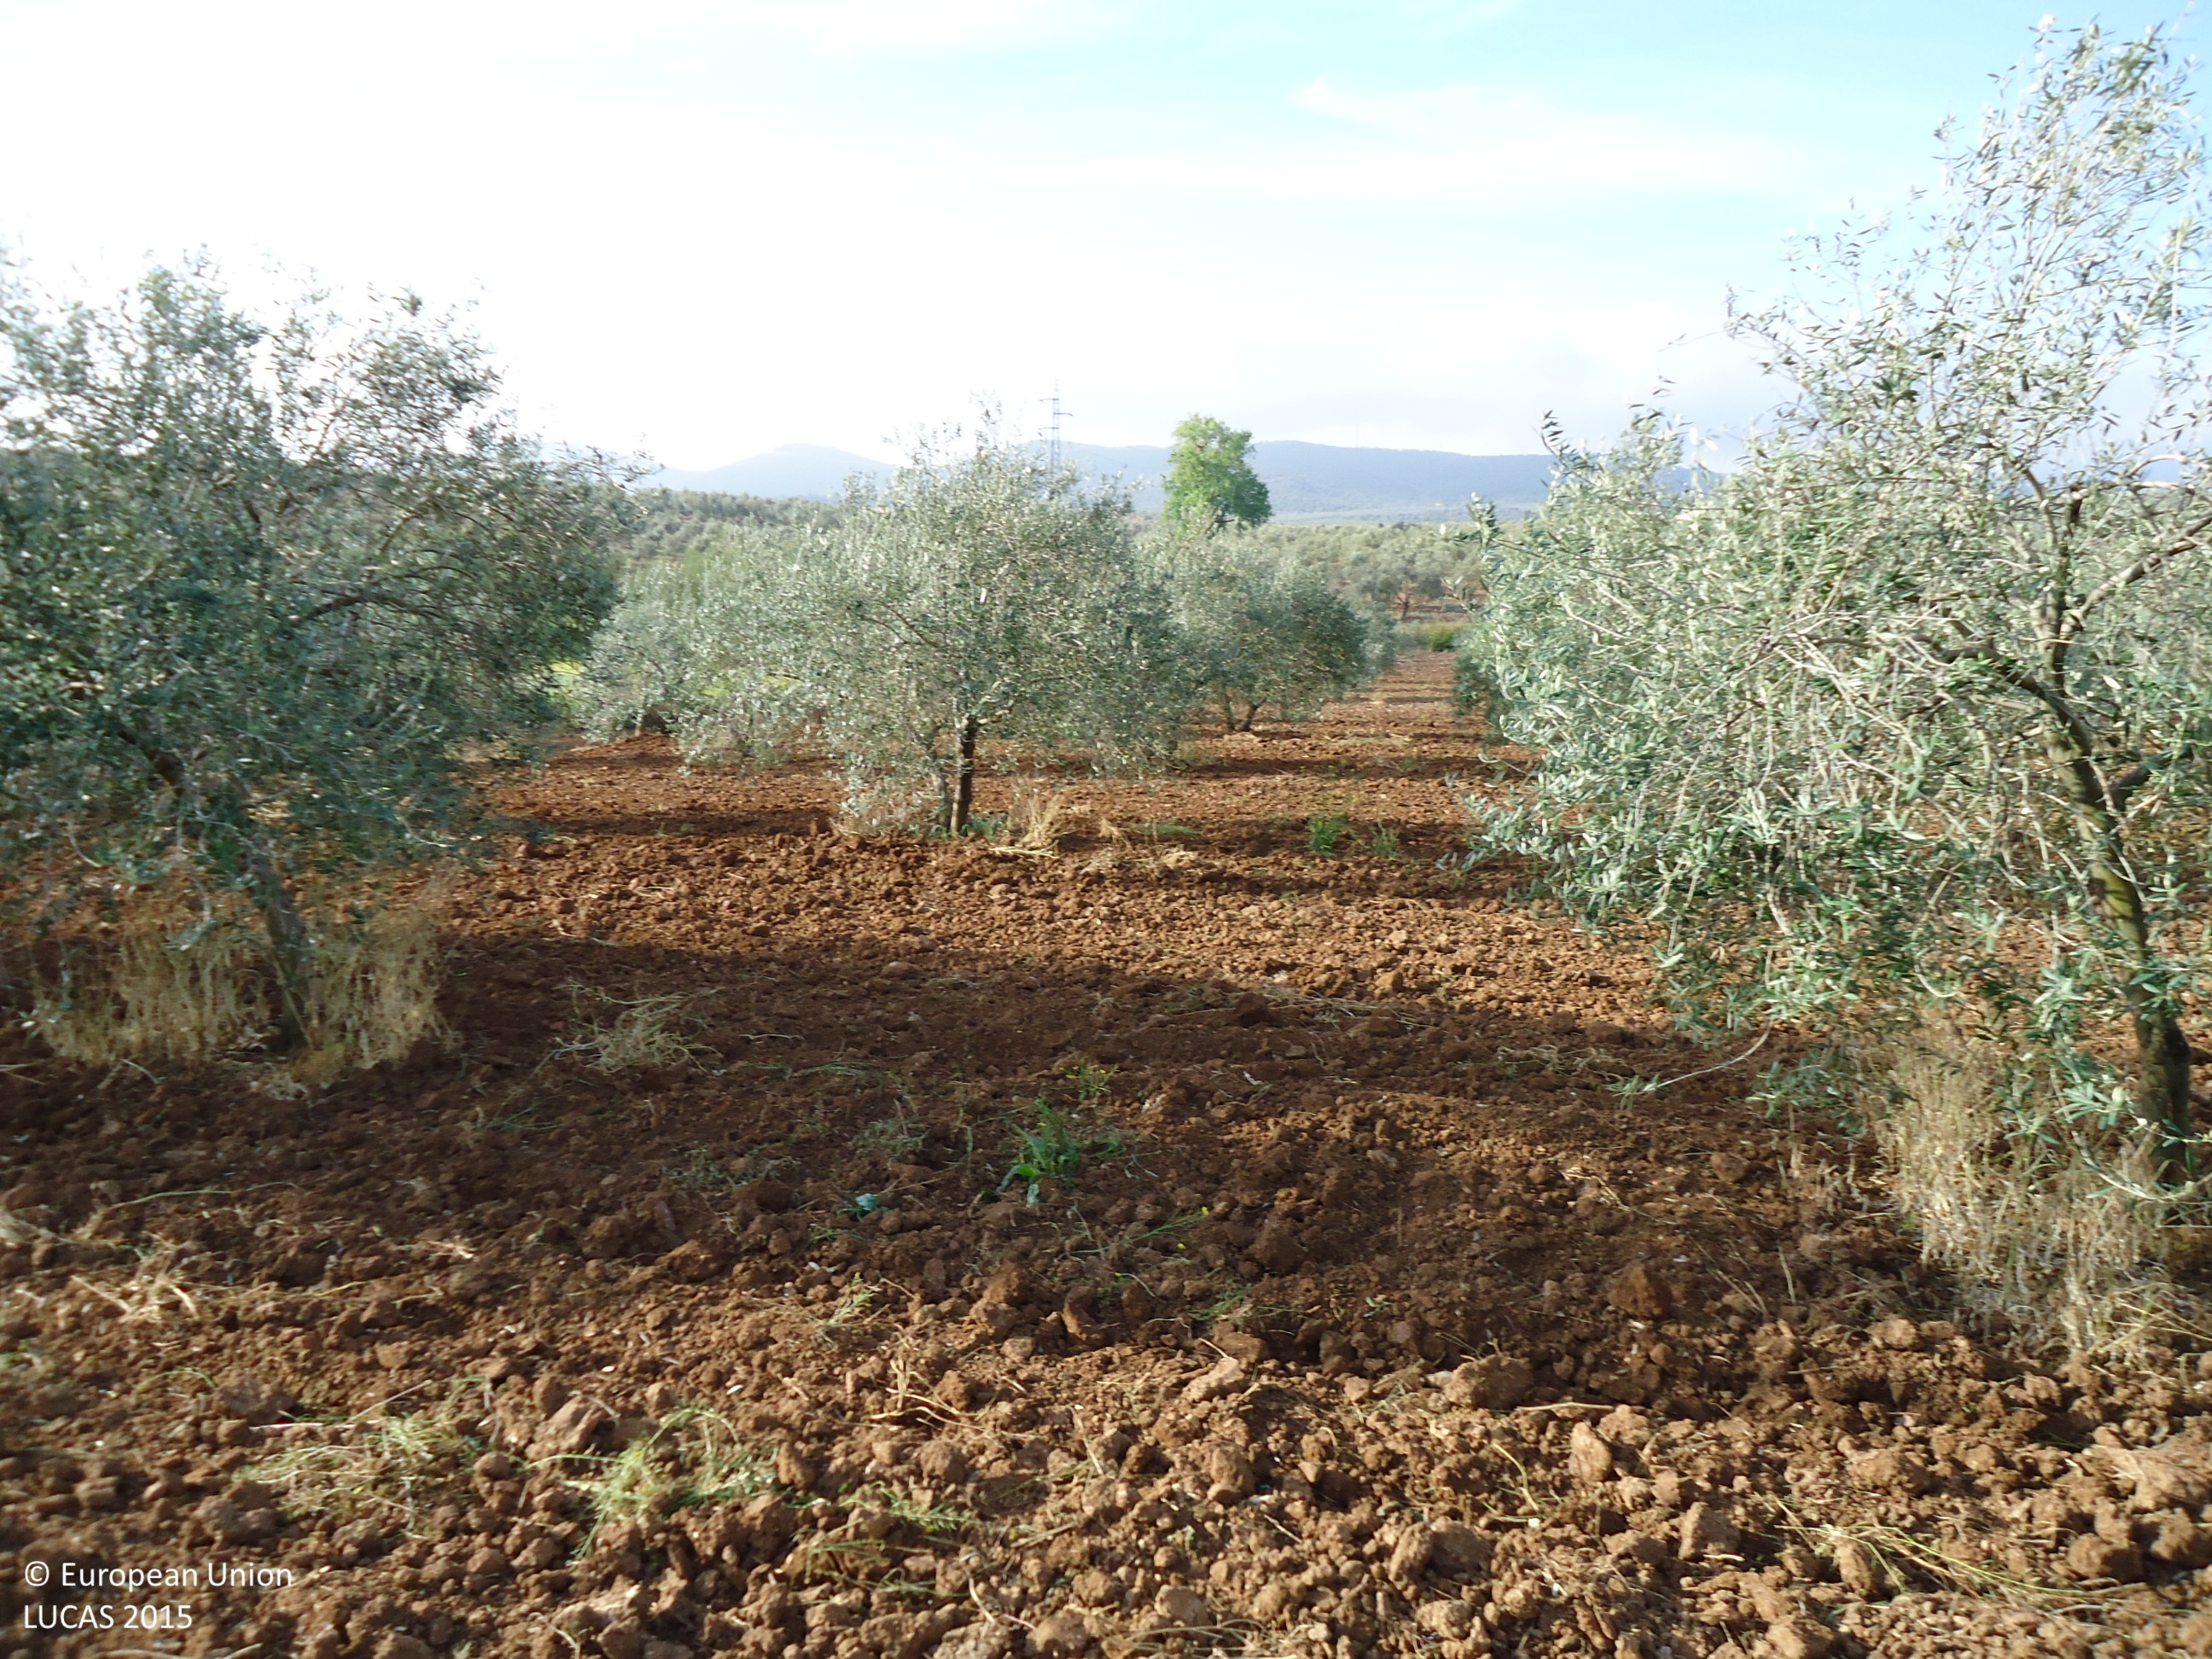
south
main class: Cropland
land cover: Olive groves
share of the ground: 25 - 50 %
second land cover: Other bare soil
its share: > 75 %
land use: Agriculture (excluding fallow land and kitchen gardens)
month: April
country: ES
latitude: 37.2015
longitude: -4.8418
